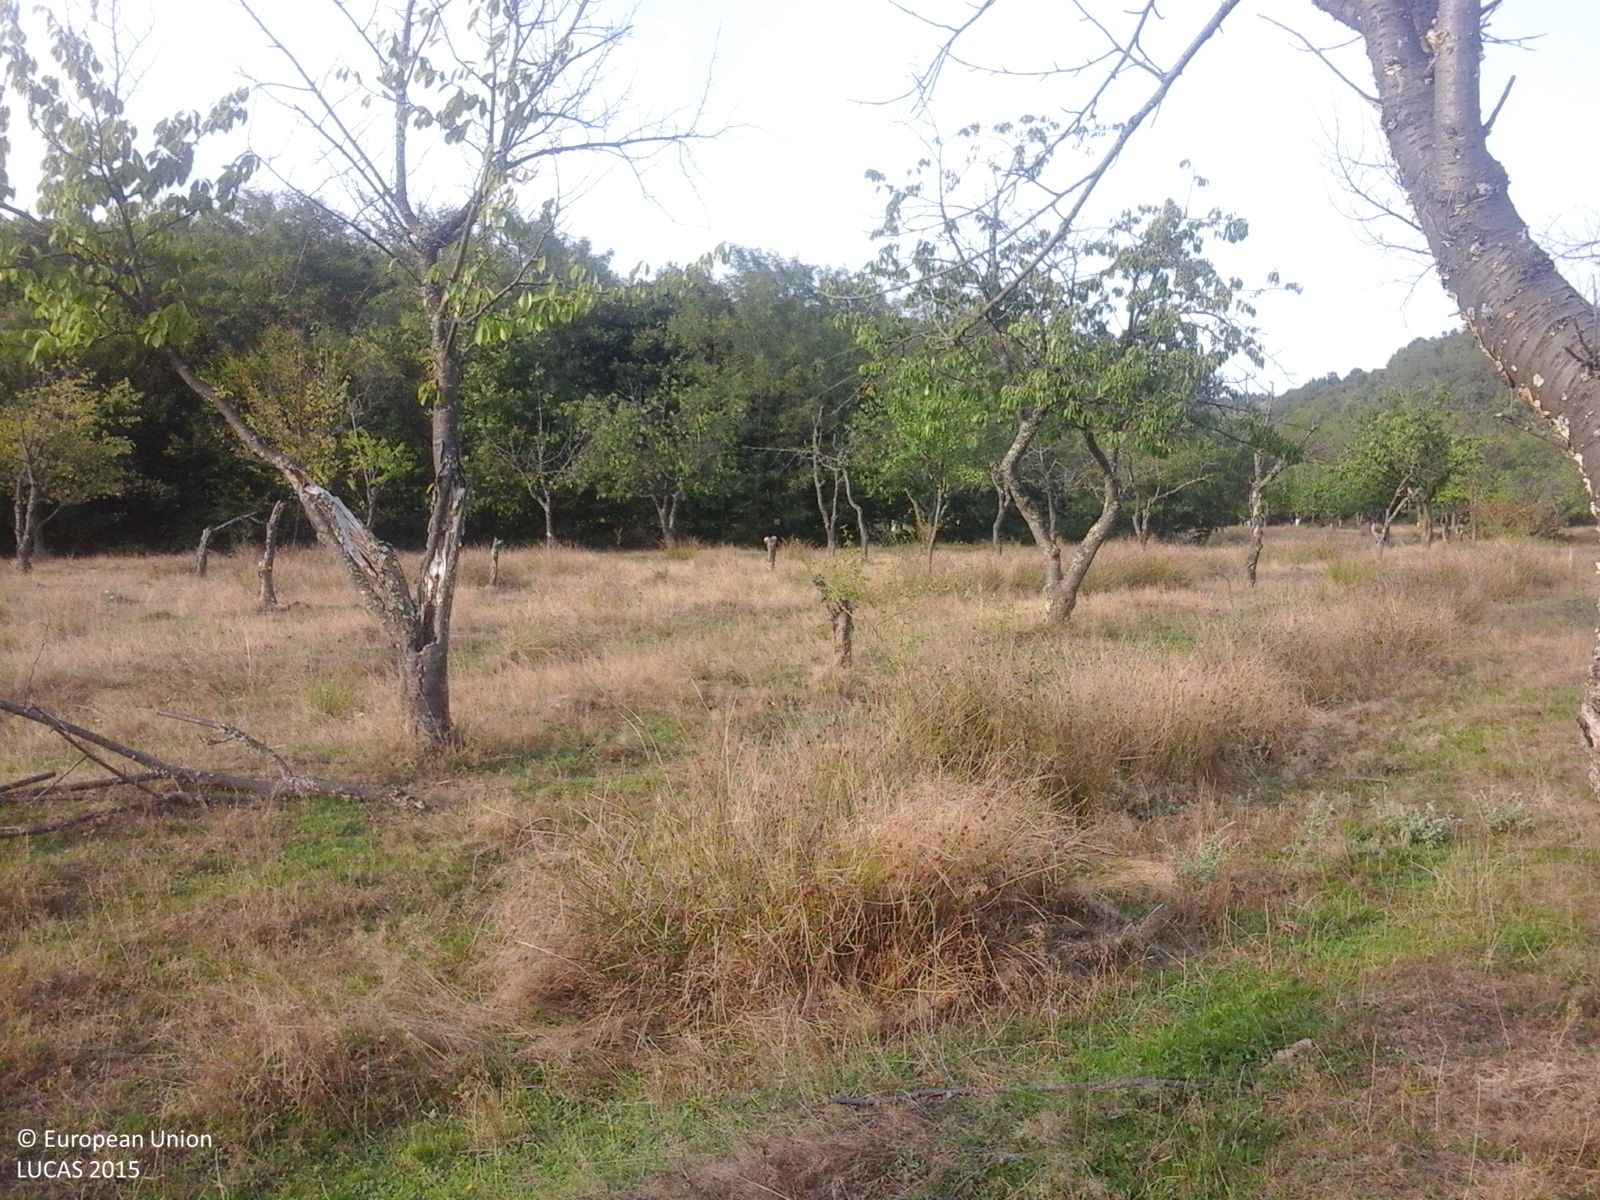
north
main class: Cropland
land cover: Cherry fruit
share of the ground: 50 - 75 %
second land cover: Grassland without tree/shrub cover
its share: > 75 %
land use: Agriculture (excluding fallow land and kitchen gardens)
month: September
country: RO
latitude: 45.5205
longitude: 22.2165
